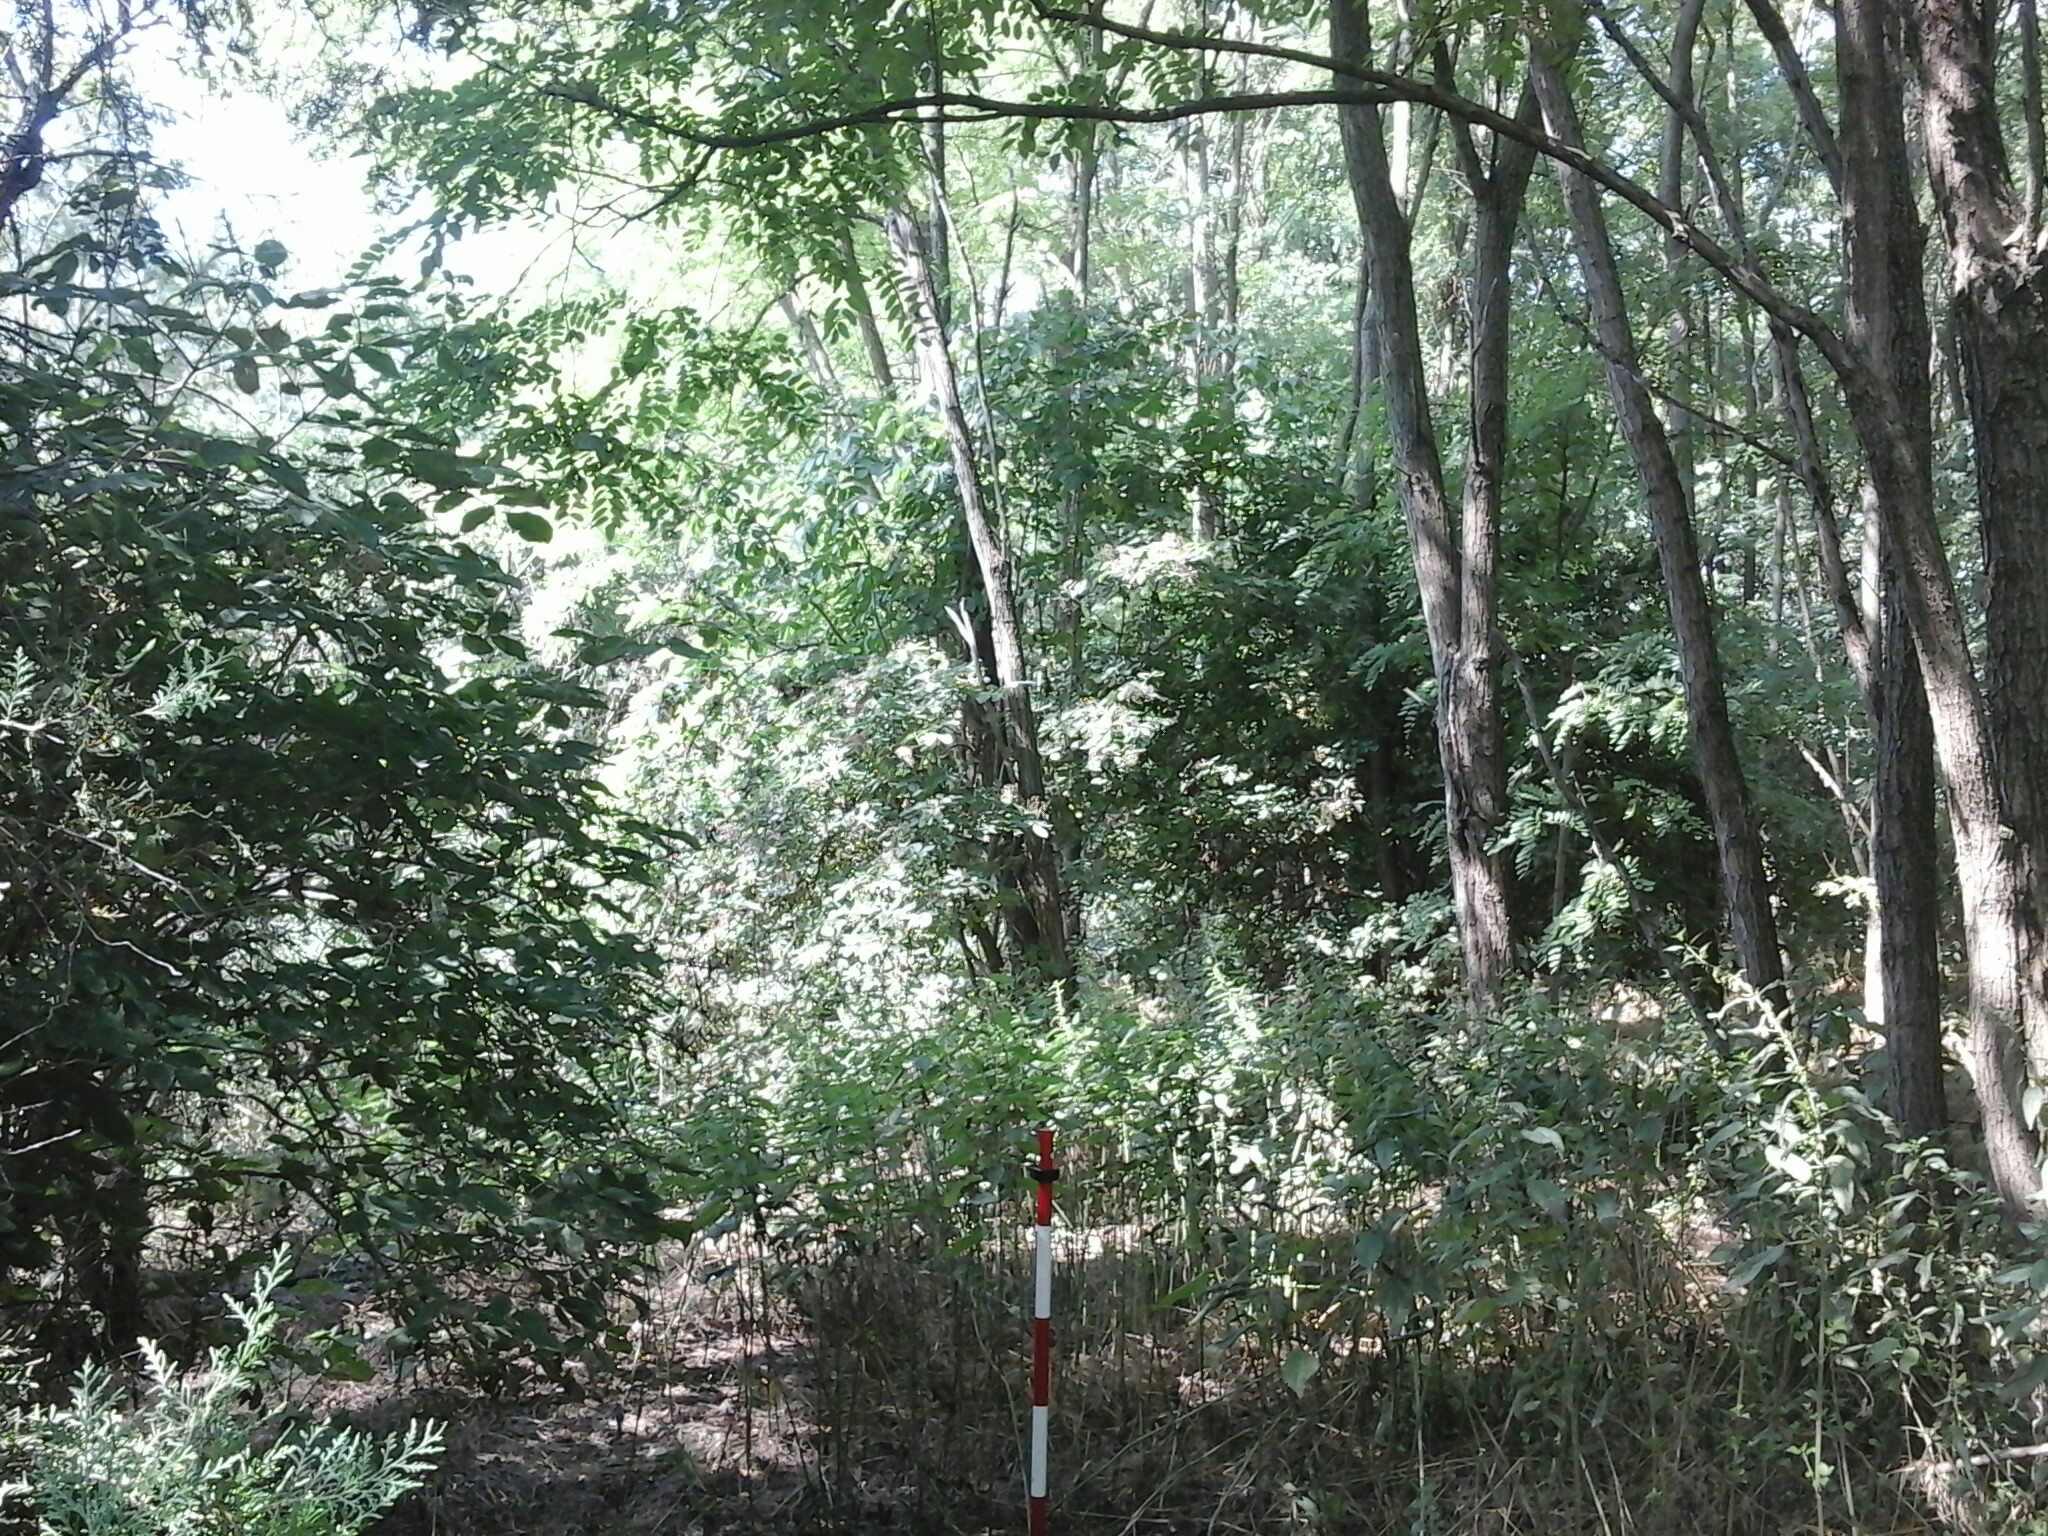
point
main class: Woodland
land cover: Broadleaved woodland
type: exotic forest
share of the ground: > 75 %
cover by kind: broadleaved forest trees 95 %, herbaceous plants 5 %
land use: Forestry
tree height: > 5 m
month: August
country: HU
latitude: 47.6225
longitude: 18.0349
